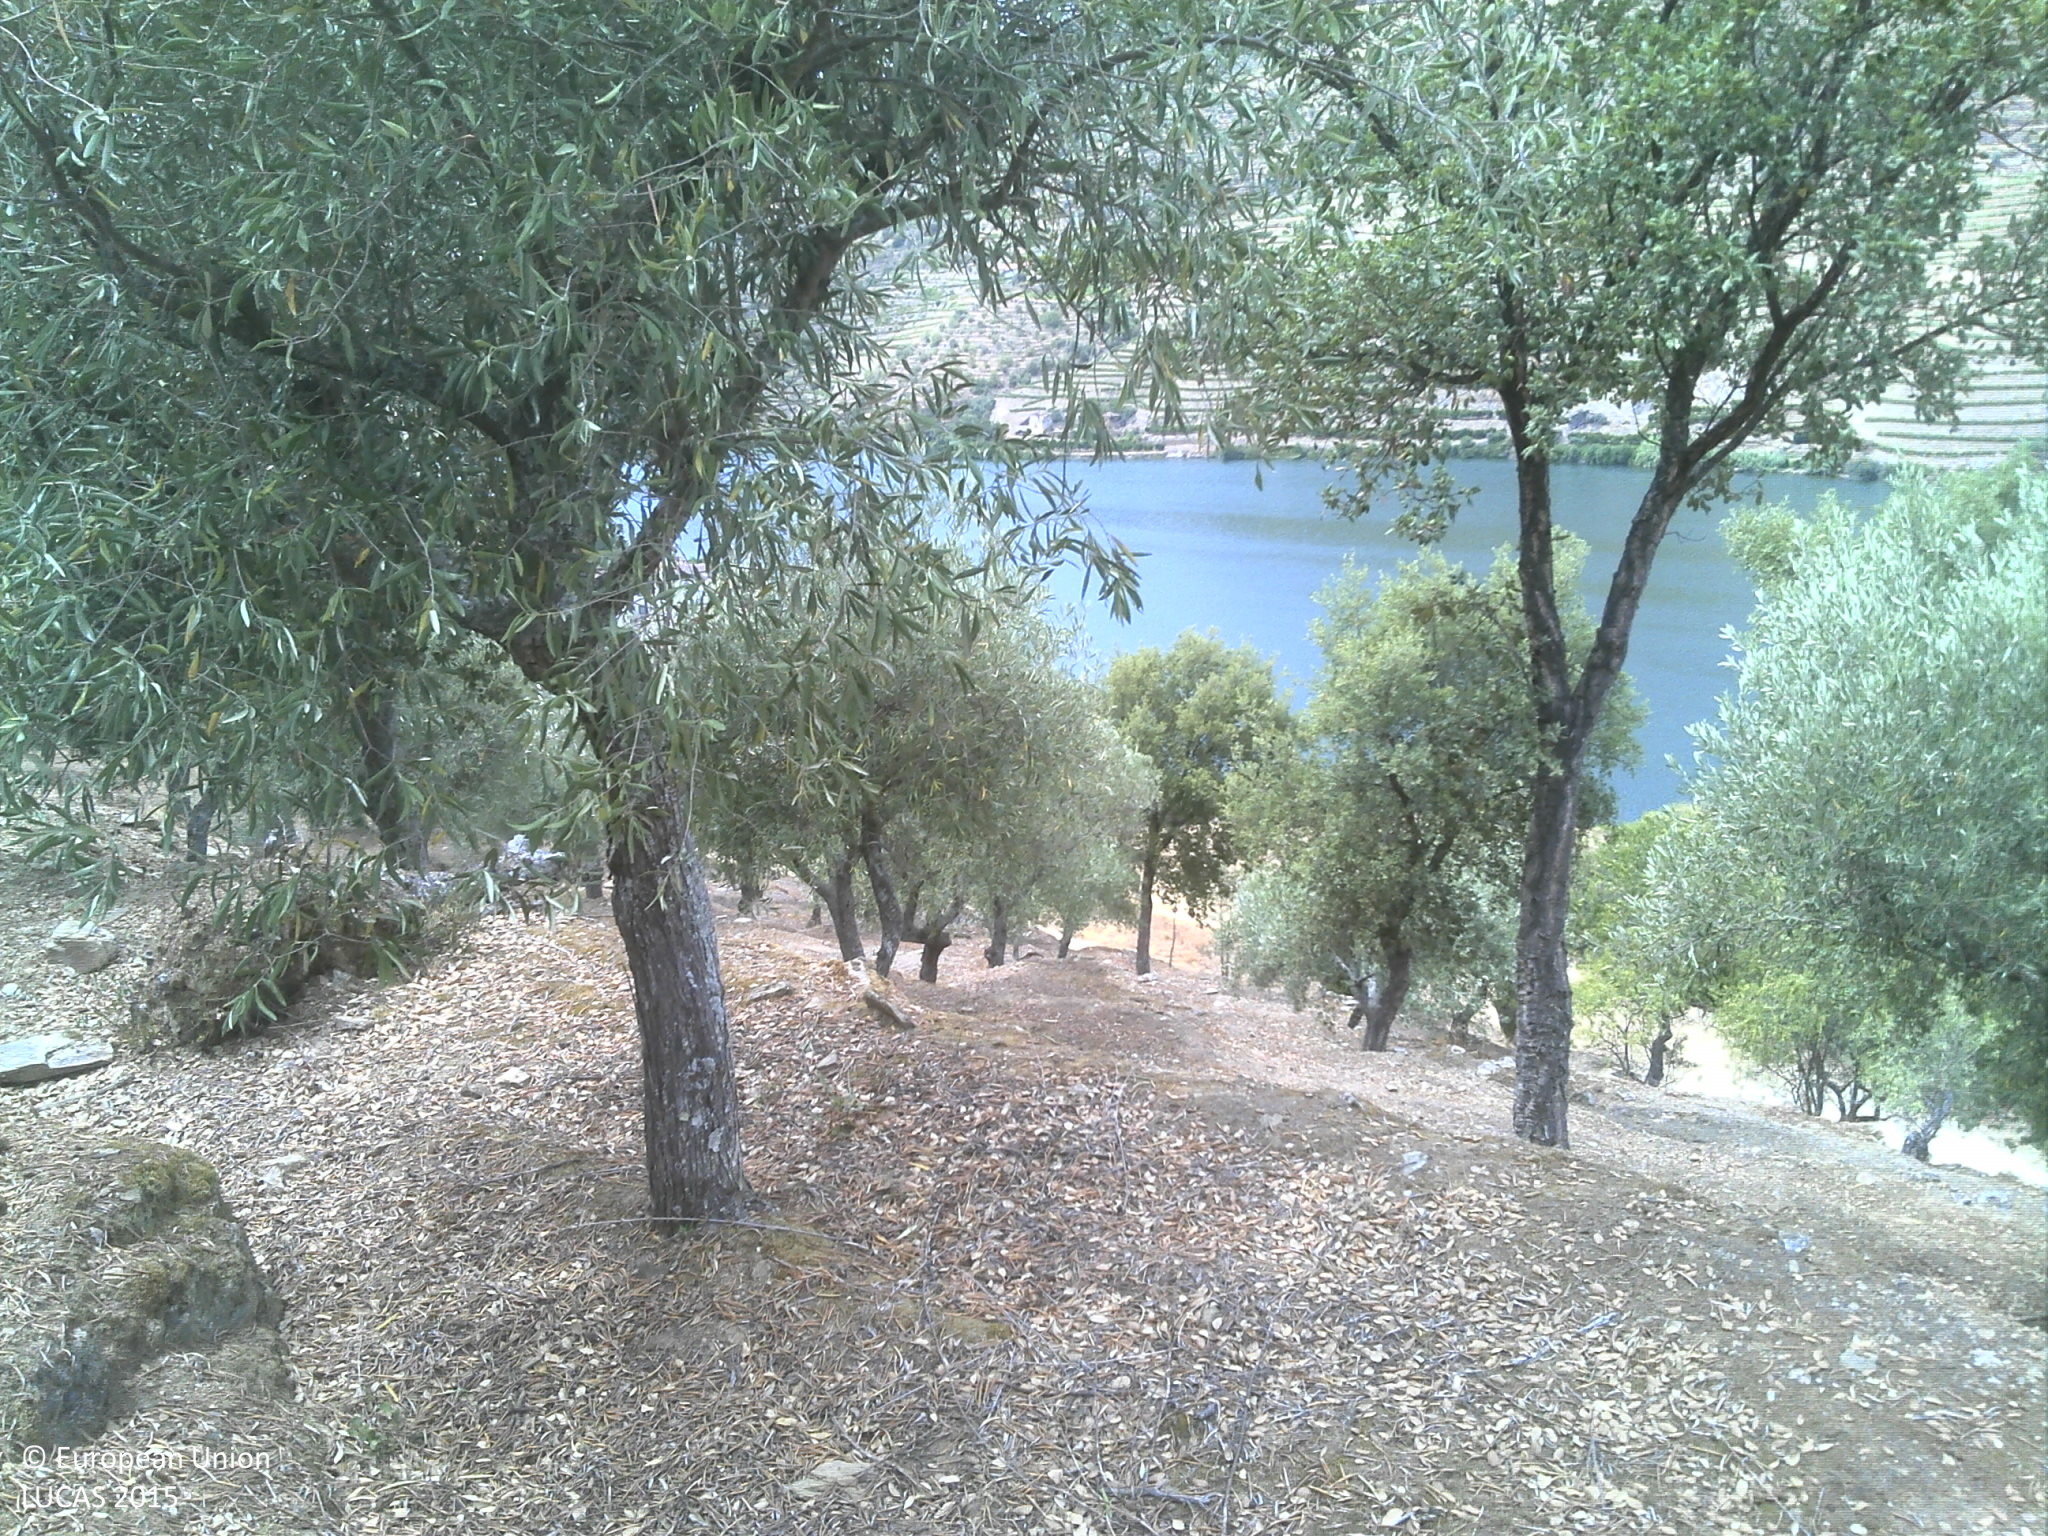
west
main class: Cropland
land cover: Olive groves
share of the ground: 25 - 50 %
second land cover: Other bare soil
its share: > 75 %
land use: Agriculture (excluding fallow land and kitchen gardens)
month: July
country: PT
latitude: 41.1407
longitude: -7.2595
